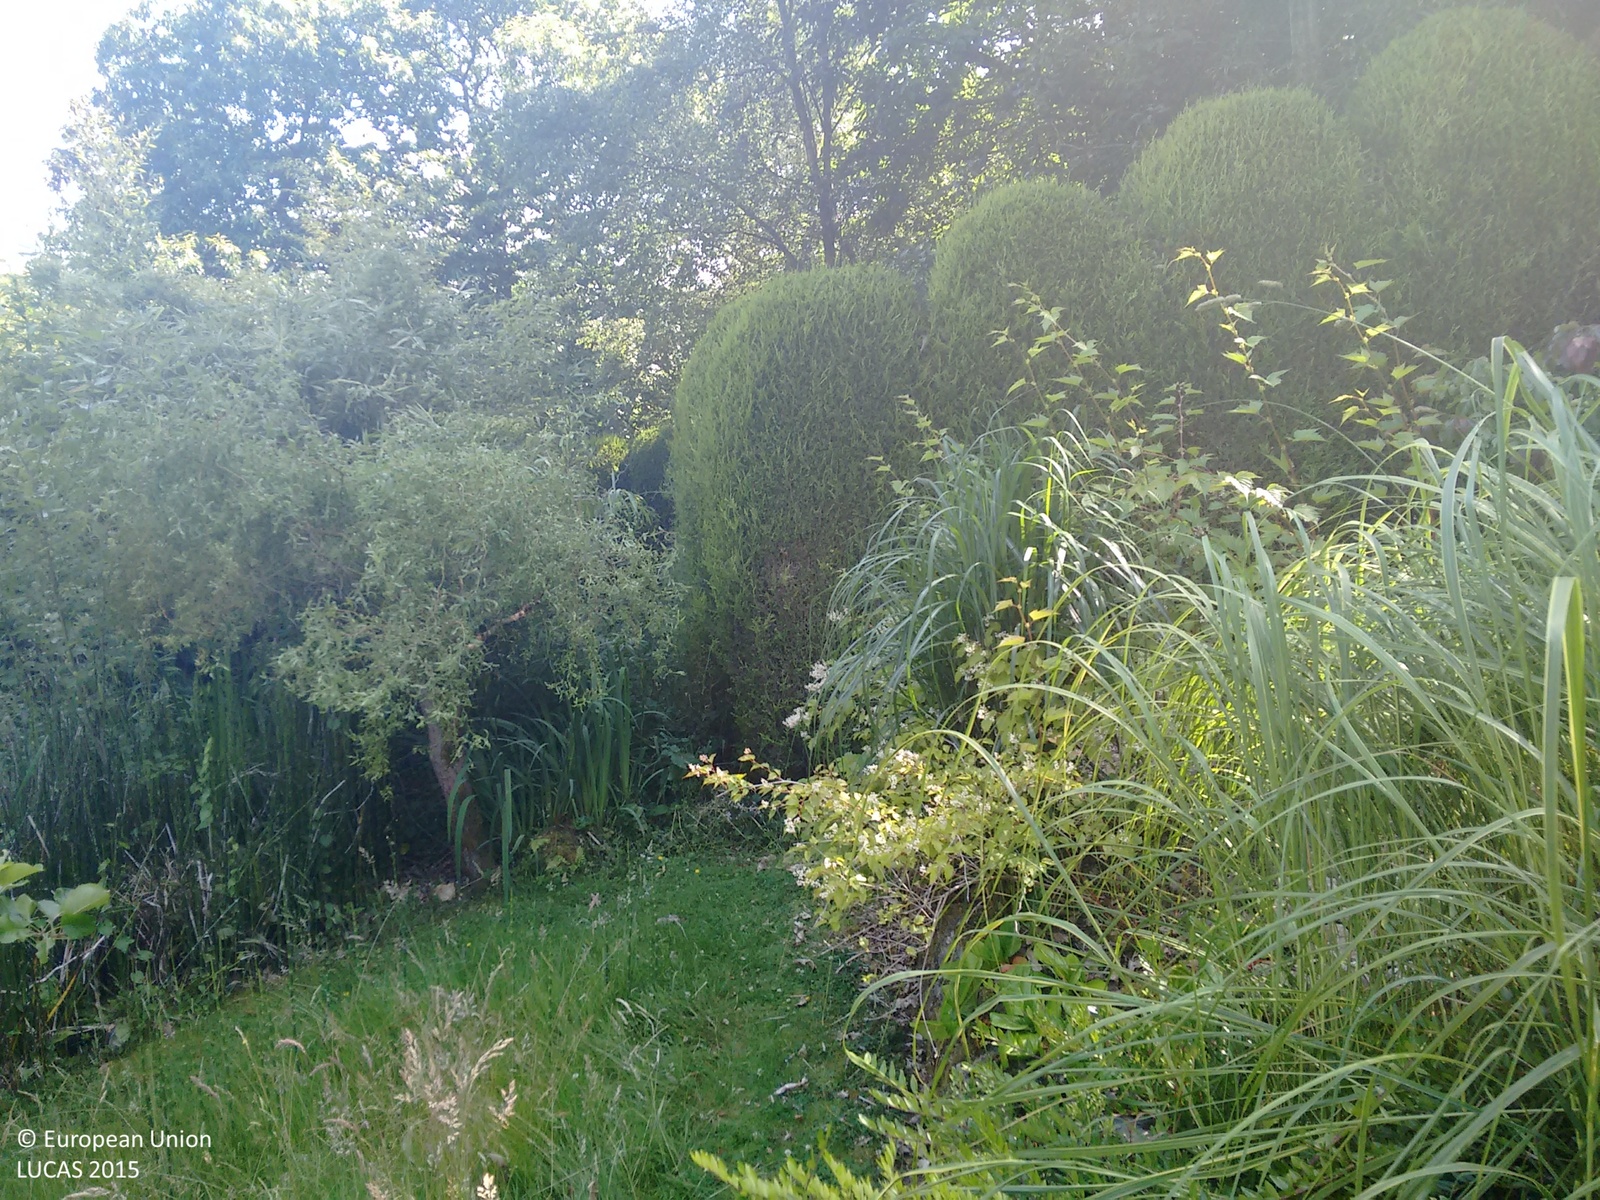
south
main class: Grassland
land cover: Grassland with sparse tree/shrub cover
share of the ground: > 75 %
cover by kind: herbaceous plants 95 %, broadleaved forest trees 5 %
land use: Residential
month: July
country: GB
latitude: 51.1702
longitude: -0.4643
